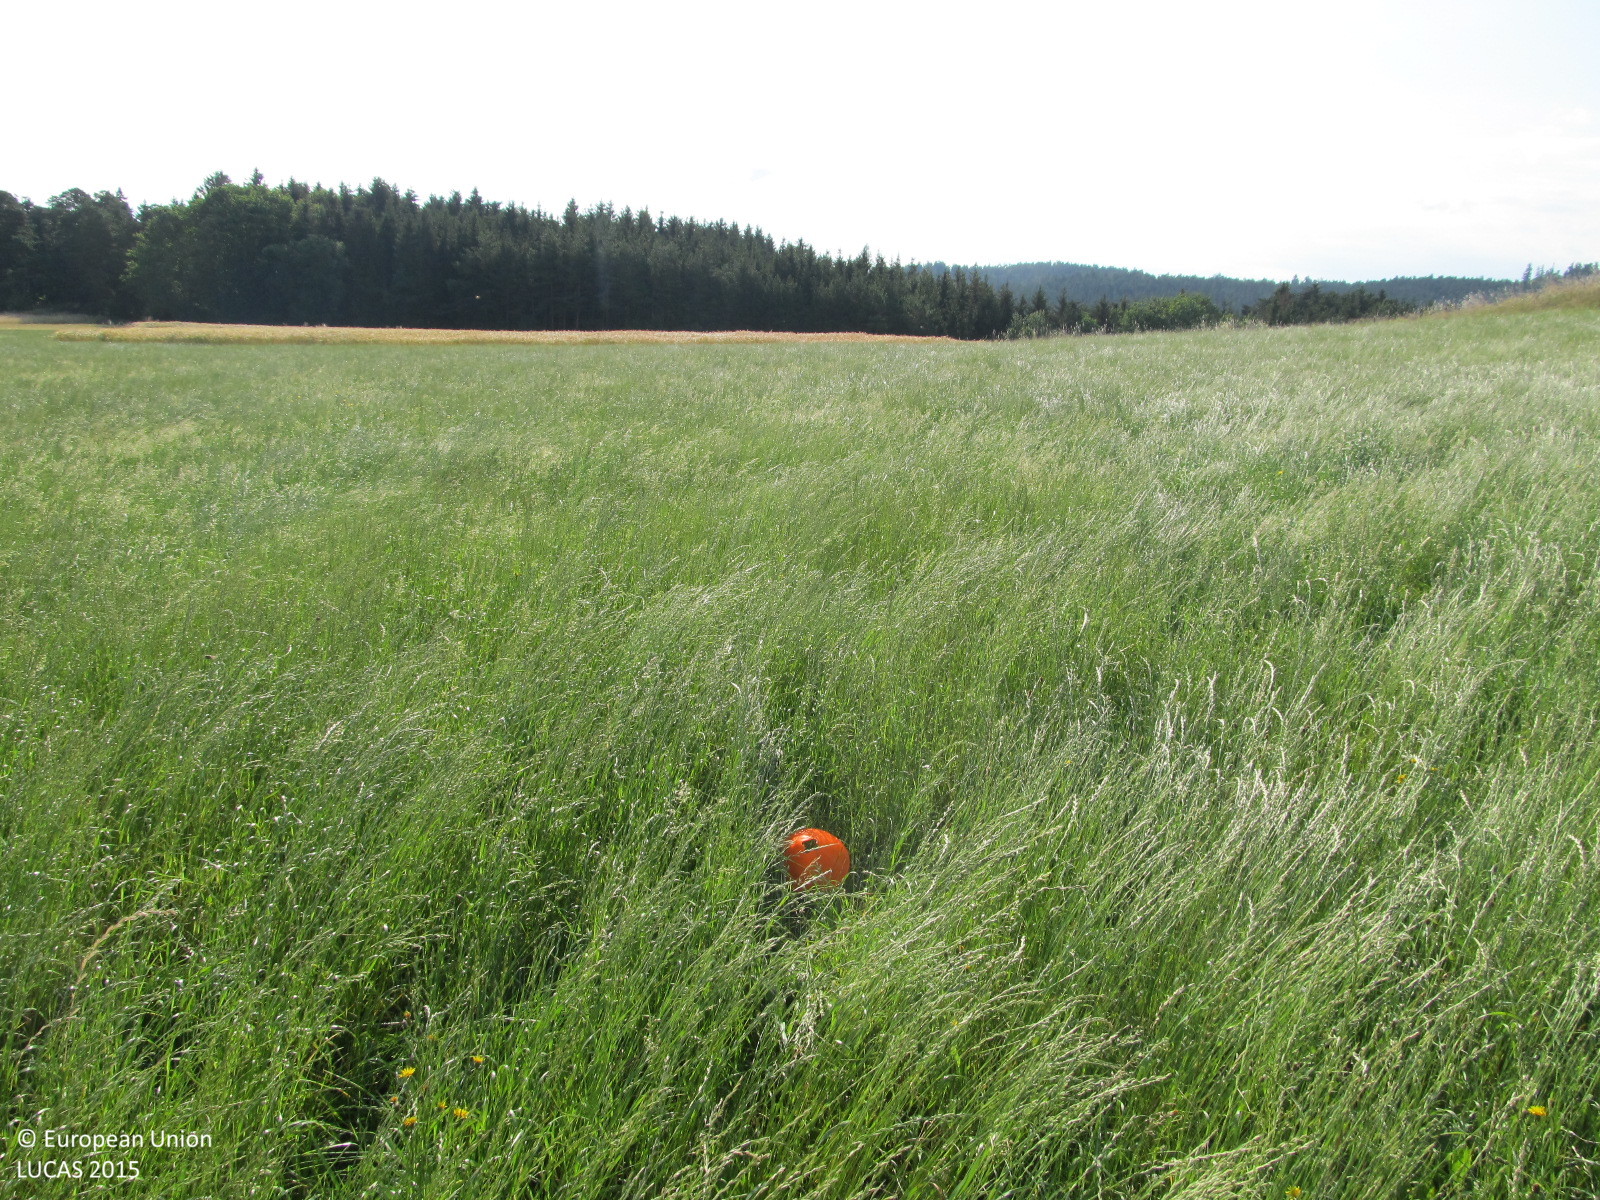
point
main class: Grassland
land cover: Grassland without tree/shrub cover
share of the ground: > 75 %
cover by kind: herbaceous plants 100 %
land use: Agriculture (excluding fallow land and kitchen gardens)
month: July
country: AT
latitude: 48.4162
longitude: 15.3934
